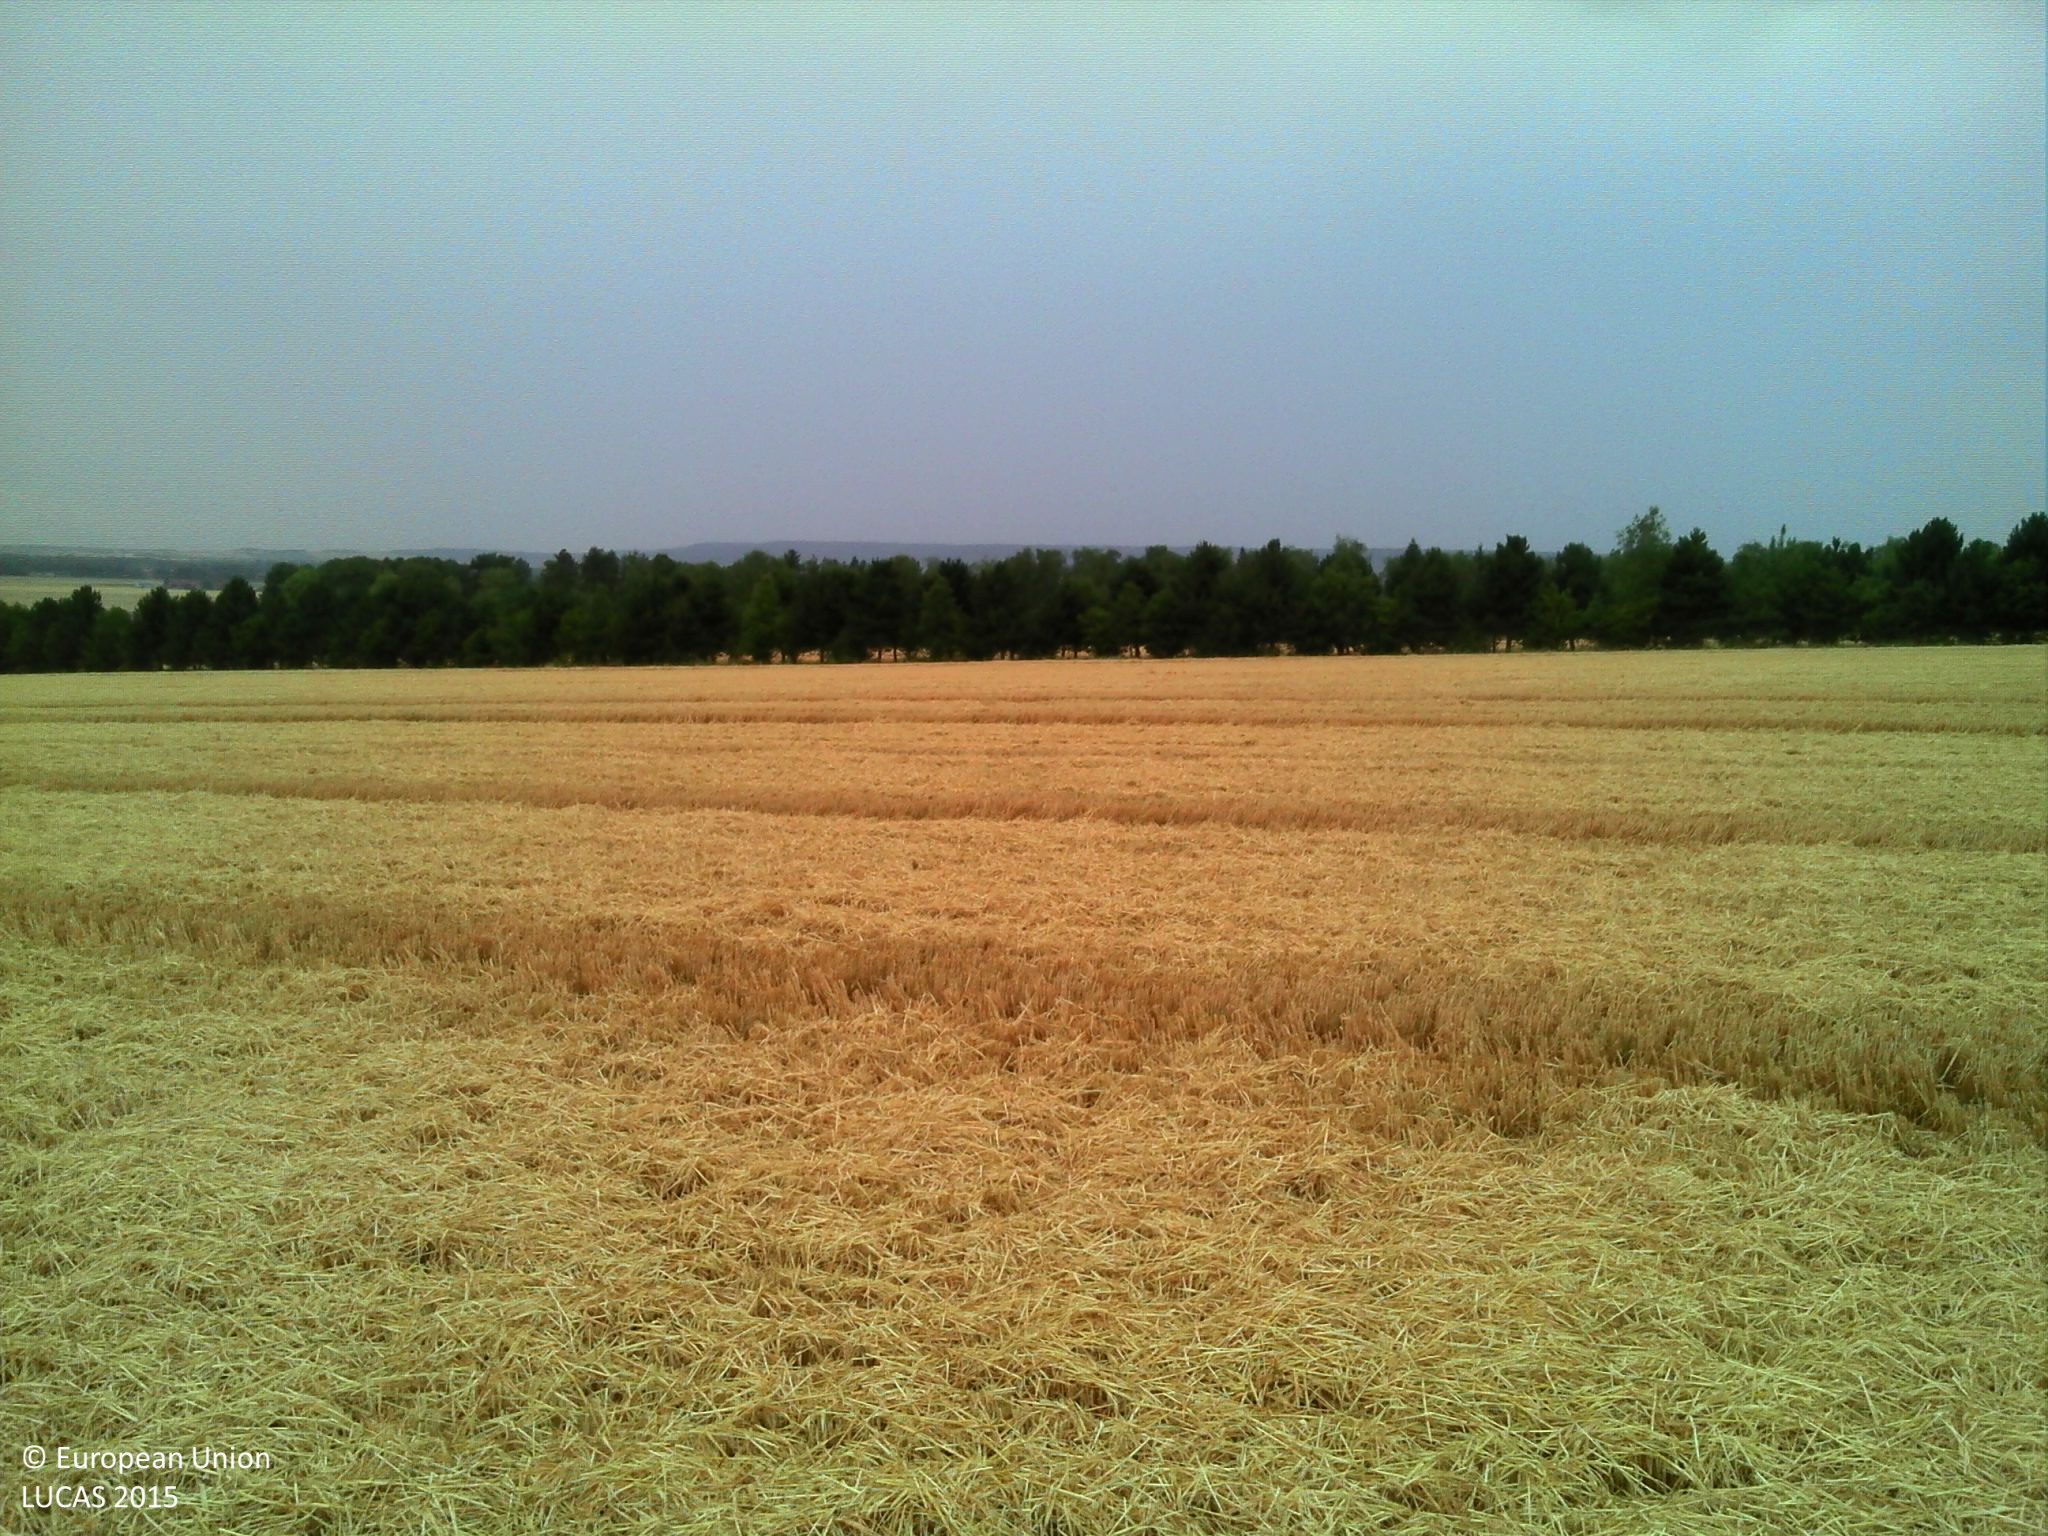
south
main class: Cropland
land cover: Rye
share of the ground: > 75 %
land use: Agriculture (excluding fallow land and kitchen gardens)
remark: Harvested field
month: July
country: FR
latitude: 49.2246
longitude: 4.1874
